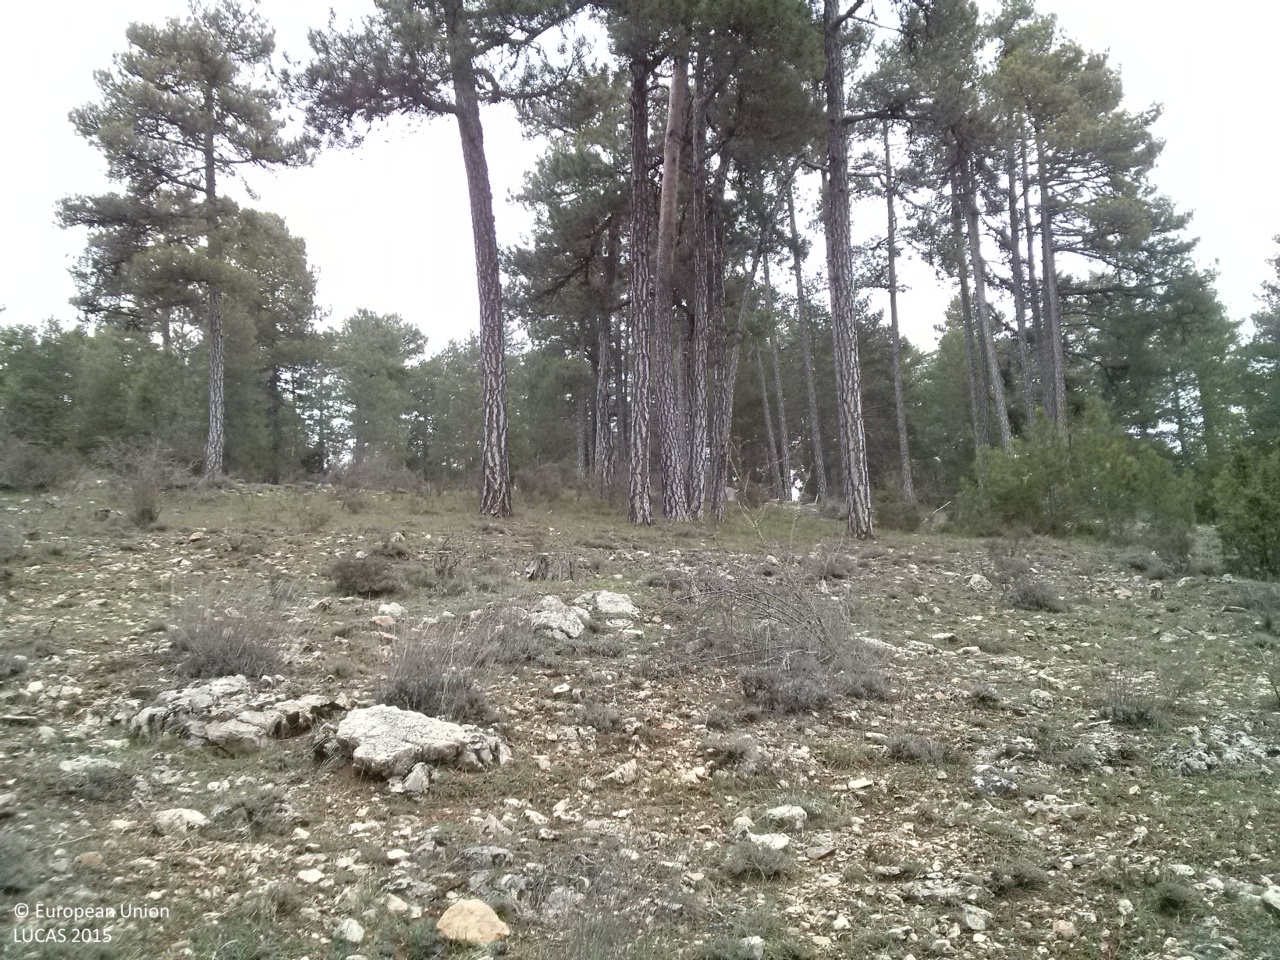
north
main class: Woodland
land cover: Pine dominated coniferous woodland
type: coniferous forest of the mediterranean region
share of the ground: 25 - 50 %
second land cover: Grassland without tree/shrub cover
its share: > 75 %
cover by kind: herbaceous plants 45 %, coniferous forest trees 25 %, consolidated bare surface 25 %, shrubs 5 %
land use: Forestry
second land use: Agriculture (excluding fallow land and kitchen gardens)
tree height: > 5 m
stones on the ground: 25 - 50 %
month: April
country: ES
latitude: 40.3182
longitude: -1.9617
